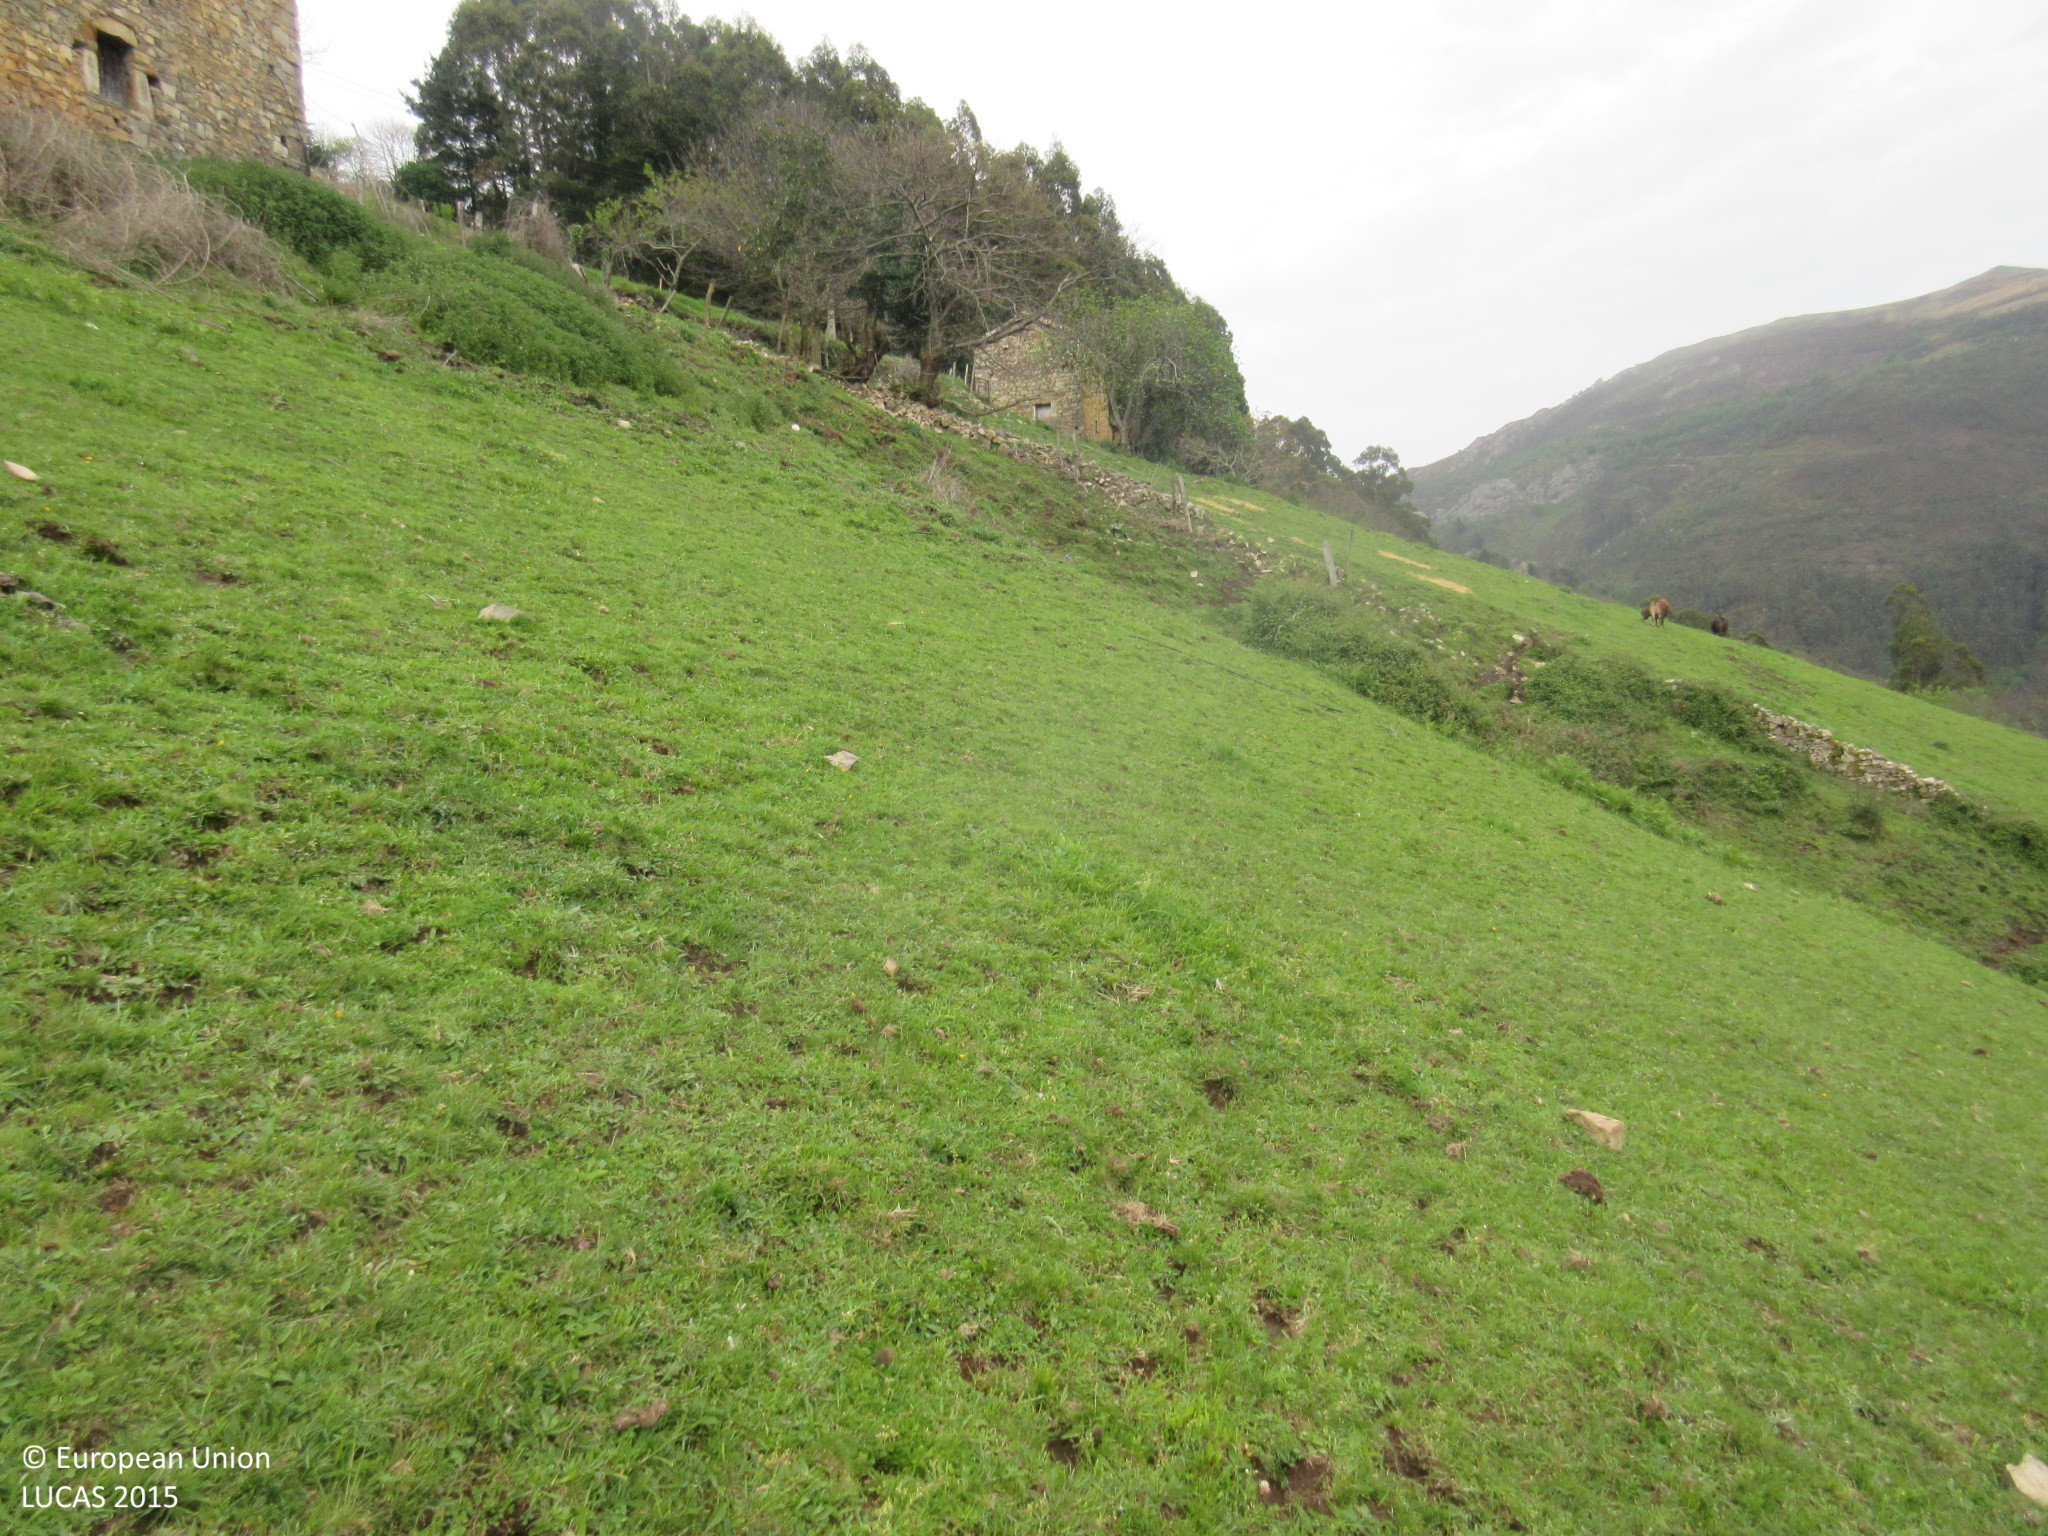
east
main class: Grassland
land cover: Grassland without tree/shrub cover
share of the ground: > 75 %
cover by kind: herbaceous plants 100 %
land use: Agriculture (excluding fallow land and kitchen gardens)
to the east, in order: Grassland without tree/shrub cover; Dry stone walls; Grassland without tree/shrub cover; Single bushes/trees; Artificial constructions in urban areas; Grassland without tree/shrub cover; Fences; Tracks; Broadleaved woodland; Pine dominated coniferous woodland; Grassland without tree/shrub cover
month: April
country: ES
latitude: 43.5138
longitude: -6.3939
